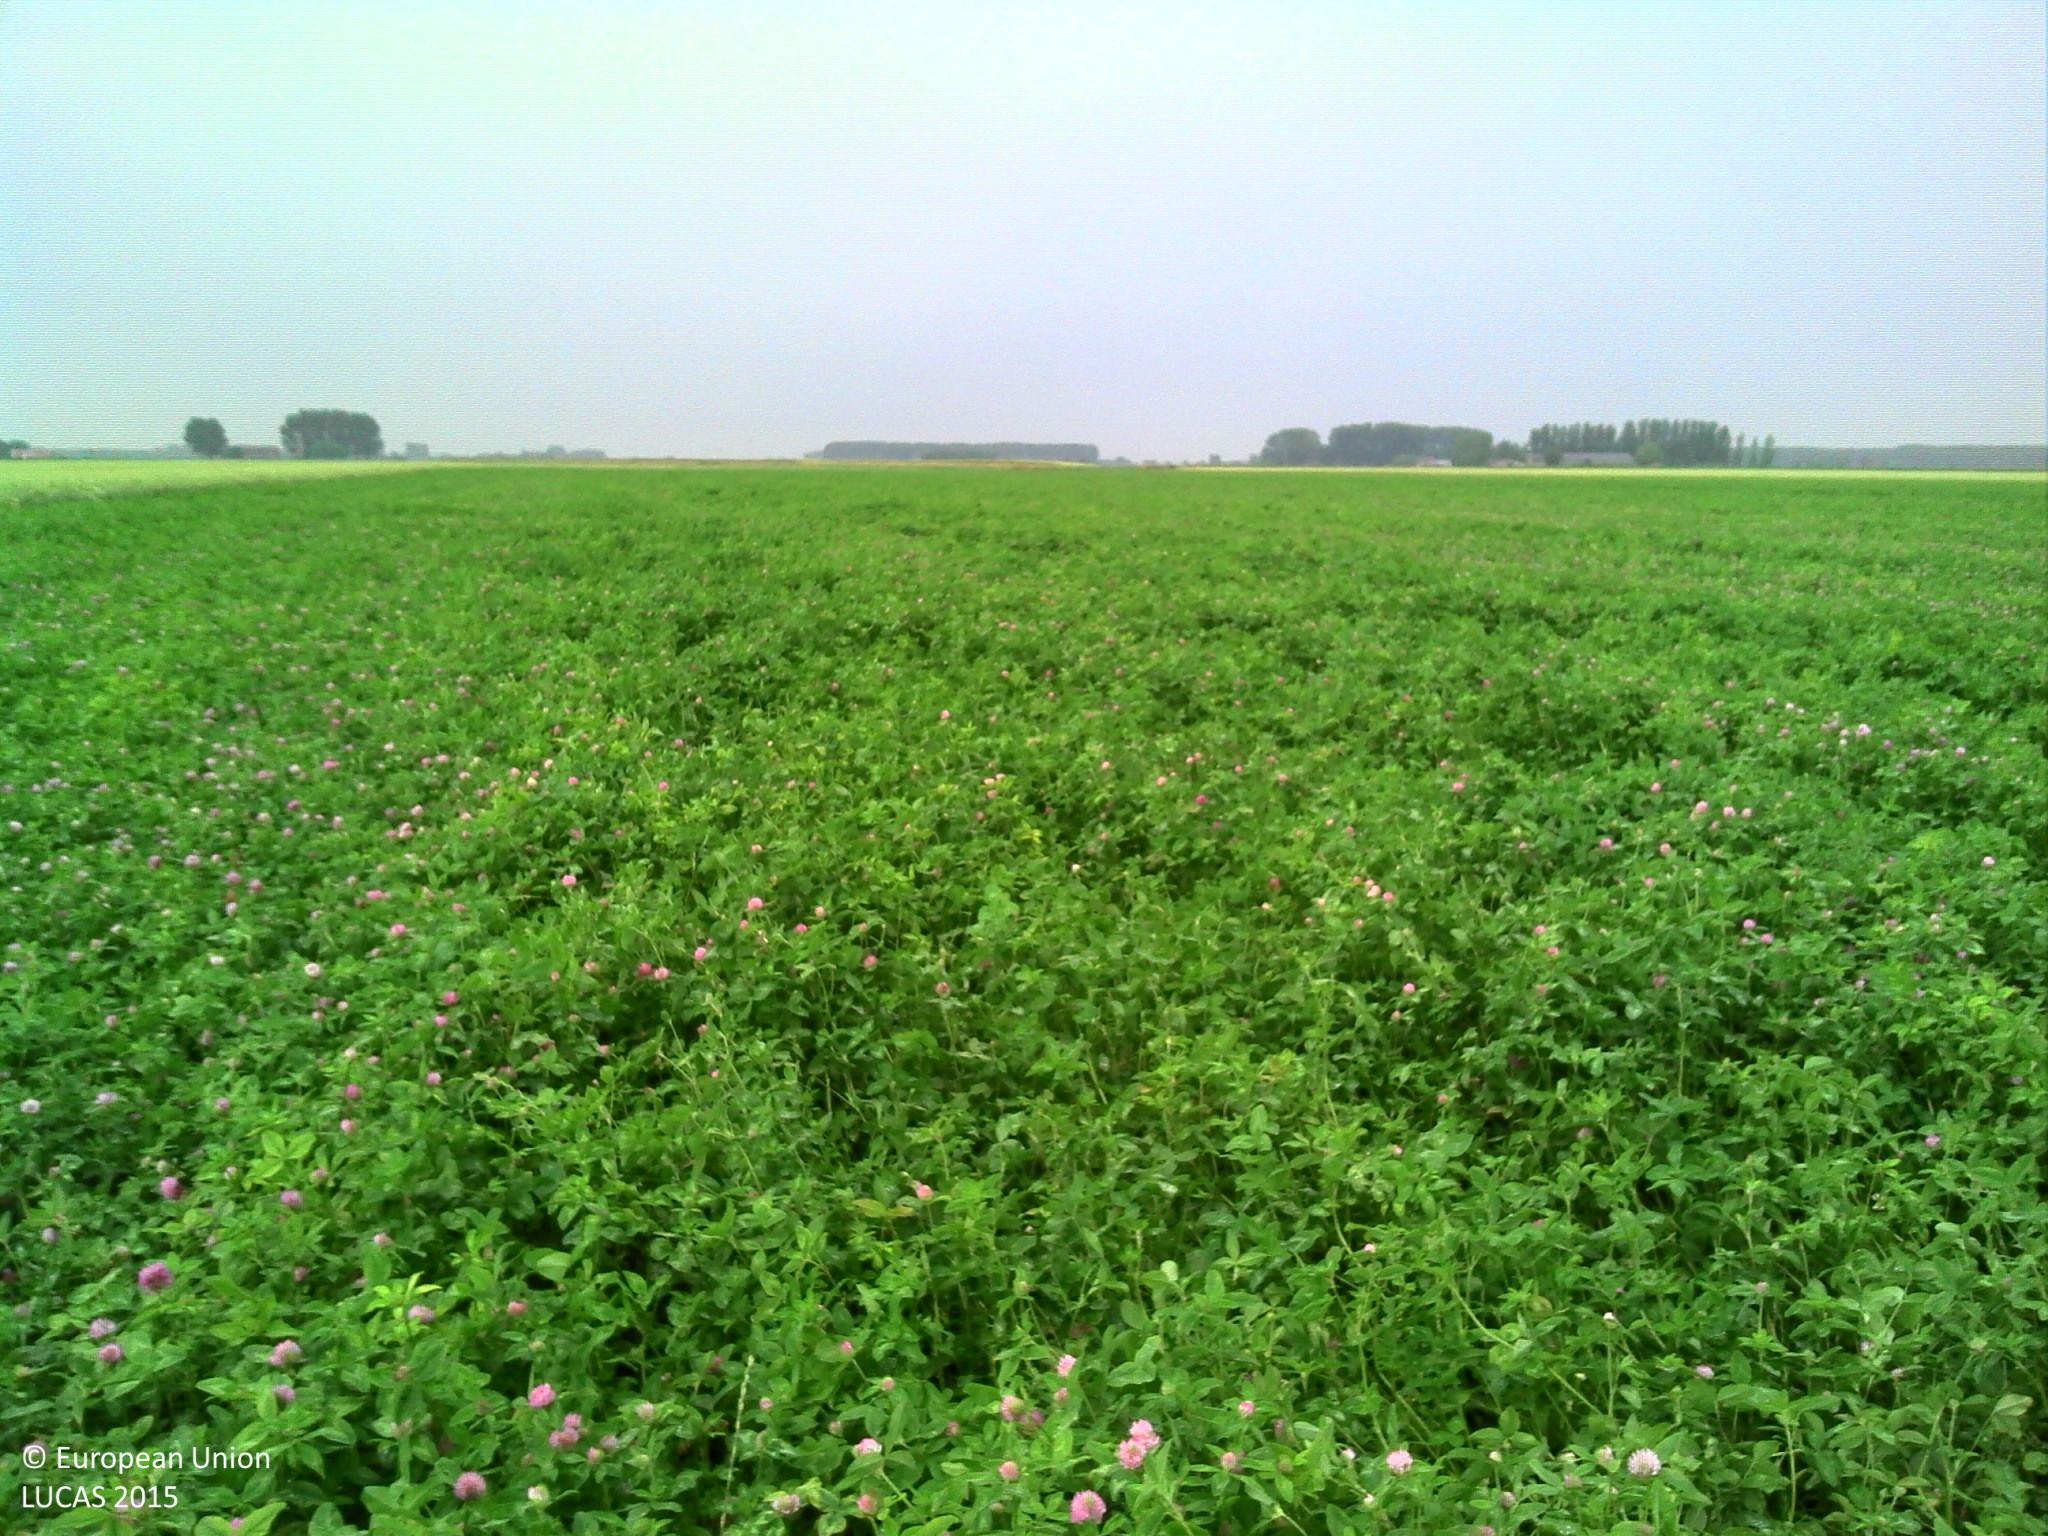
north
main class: Cropland
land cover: Clovers
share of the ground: > 75 %
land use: Agriculture (excluding fallow land and kitchen gardens)
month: July
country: BE
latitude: 51.2826
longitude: 3.5550
